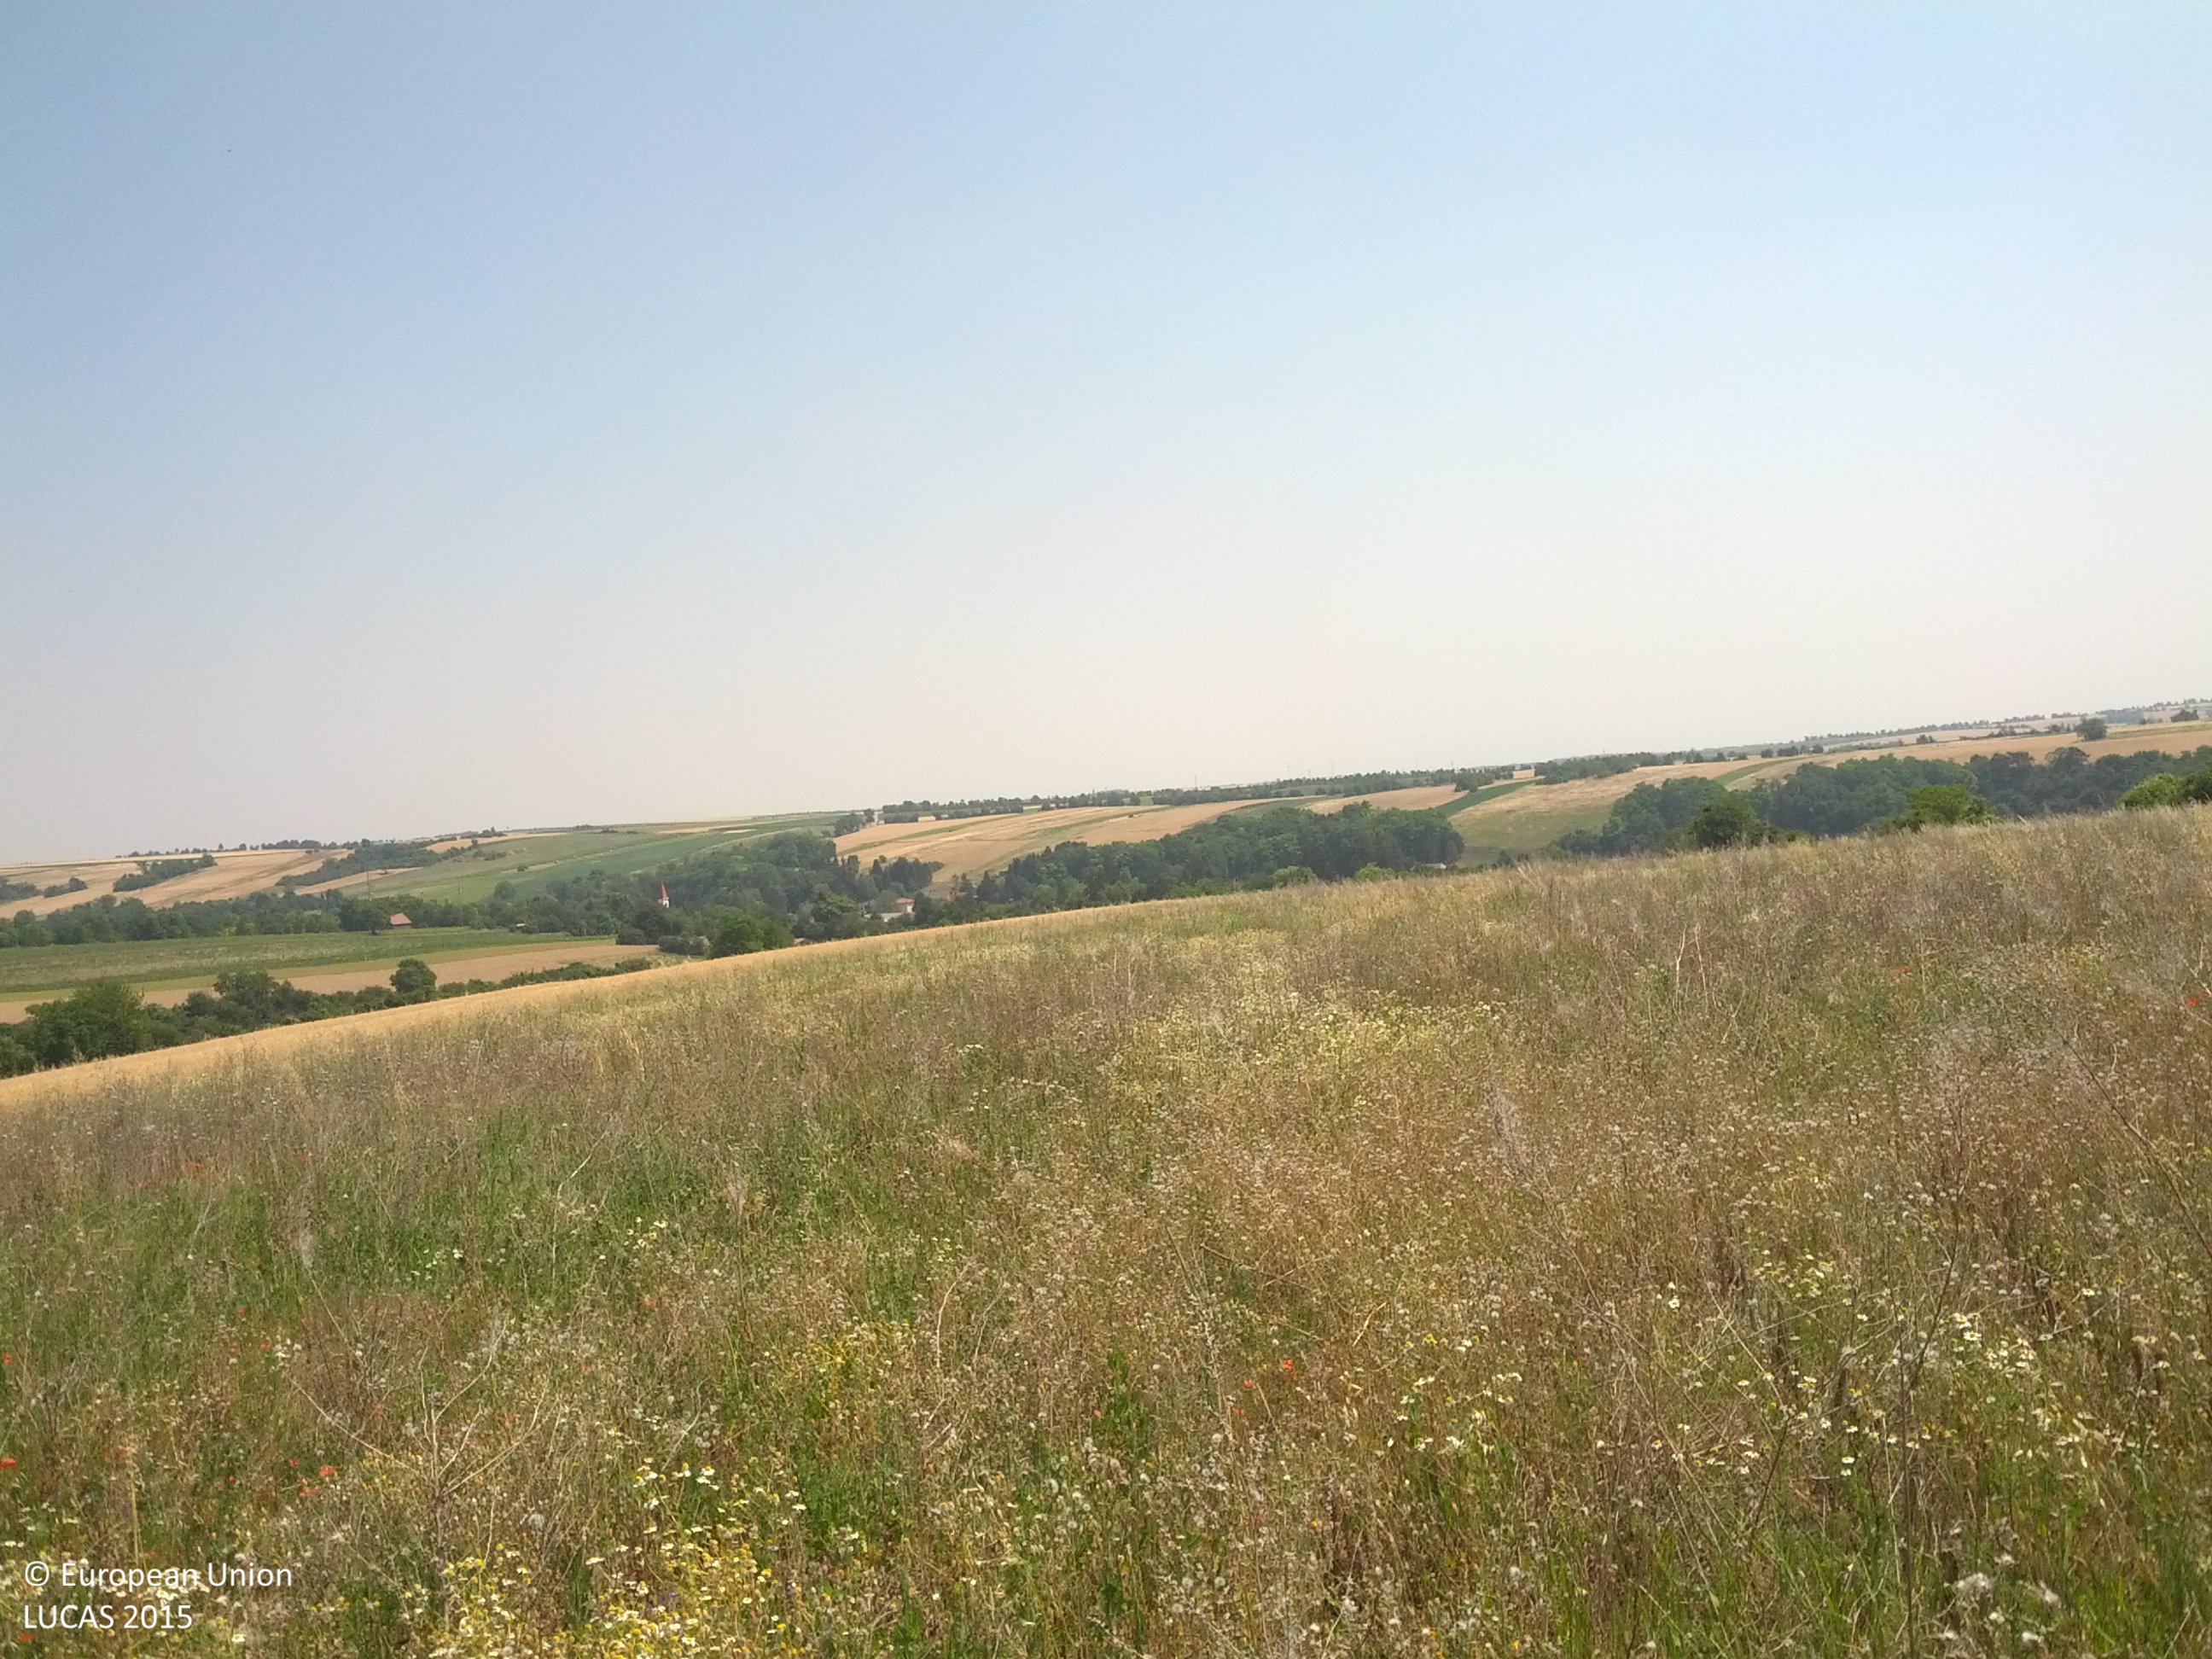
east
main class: Grassland
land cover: Spontaneously vegetated surfaces
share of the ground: > 75 %
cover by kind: herbaceous plants 100 %
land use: Fallow land
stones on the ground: < 10 %
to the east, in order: Spontaneously vegetated surfaces; Grassland without tree/shrub cover; Common wheat
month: July
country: AT
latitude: 48.4479
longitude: 16.4819
